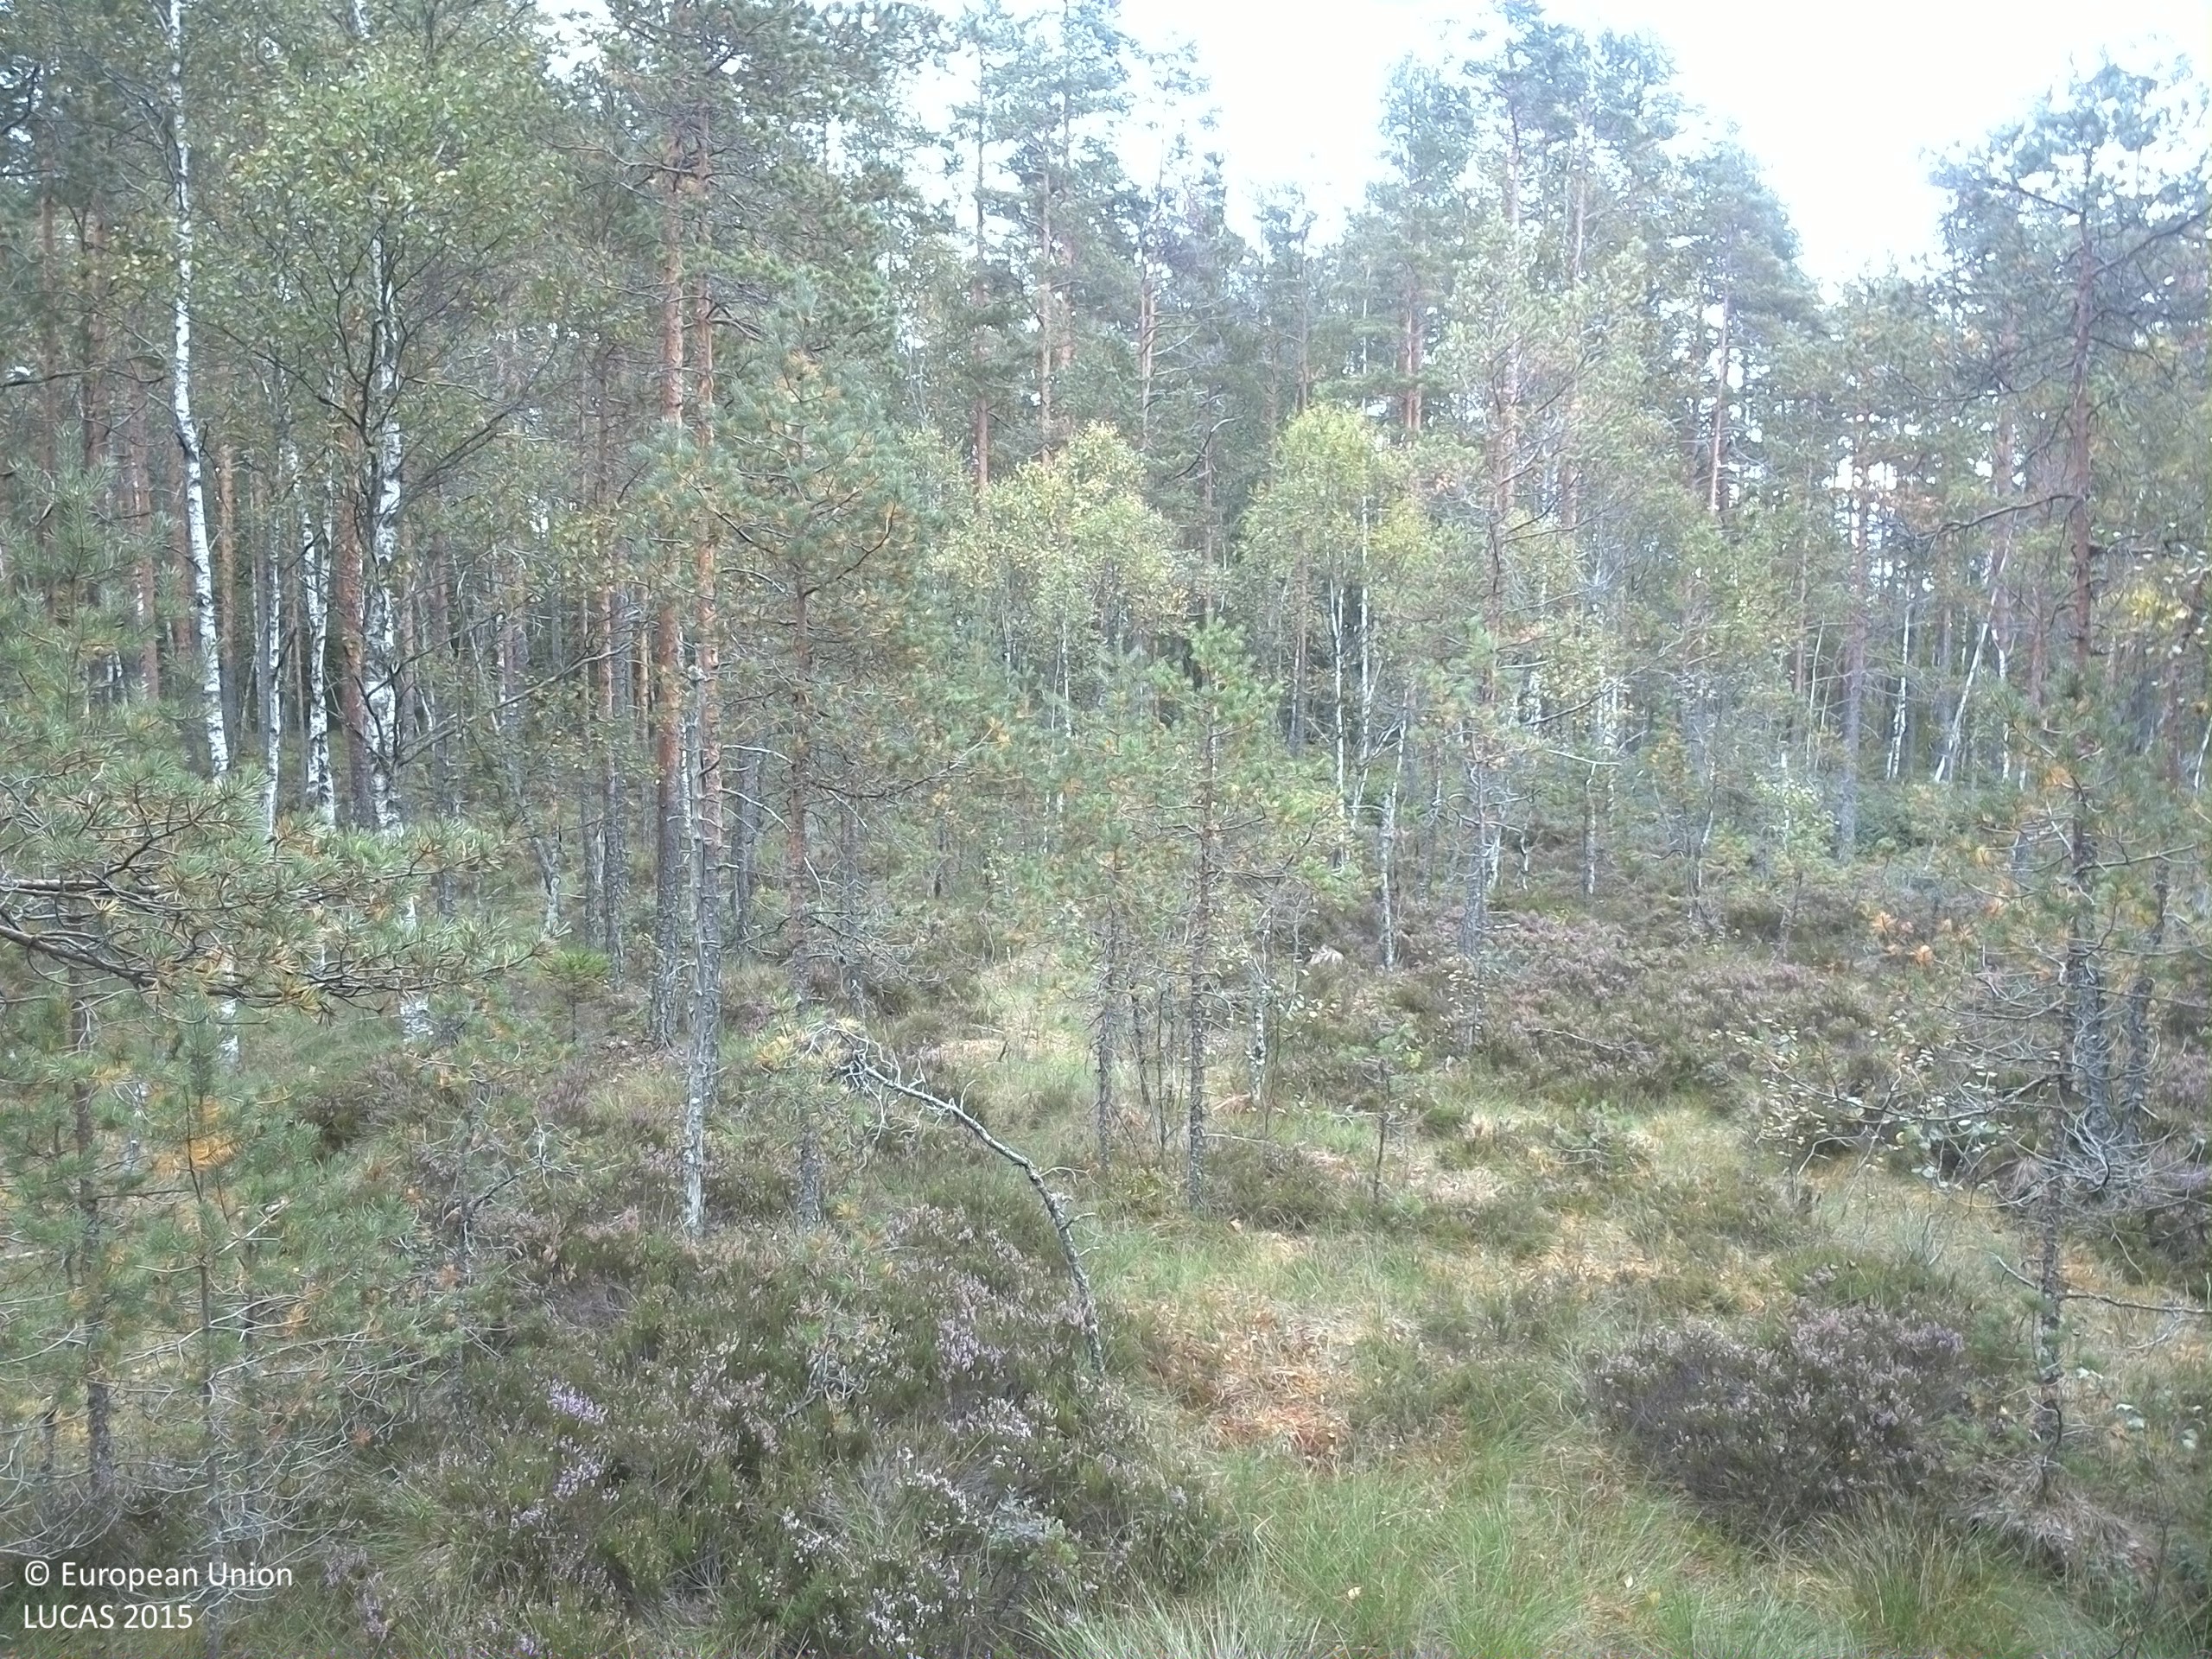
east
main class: Woodland
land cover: Pine dominated mixed woodland
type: boreal forest
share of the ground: 50 - 75 %
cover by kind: coniferous forest trees 40 %, broadleaved forest trees 25 %, shrubs 25 %, lichens and mosses 10 %
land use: Forestry
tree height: > 5 m
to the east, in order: Pine dominated mixed woodland; Rivers and streams; Pine dominated mixed woodland; Pine dominated coniferous woodland; Pine dominated mixed woodland
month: September
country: SE
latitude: 59.7983
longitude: 13.3598
